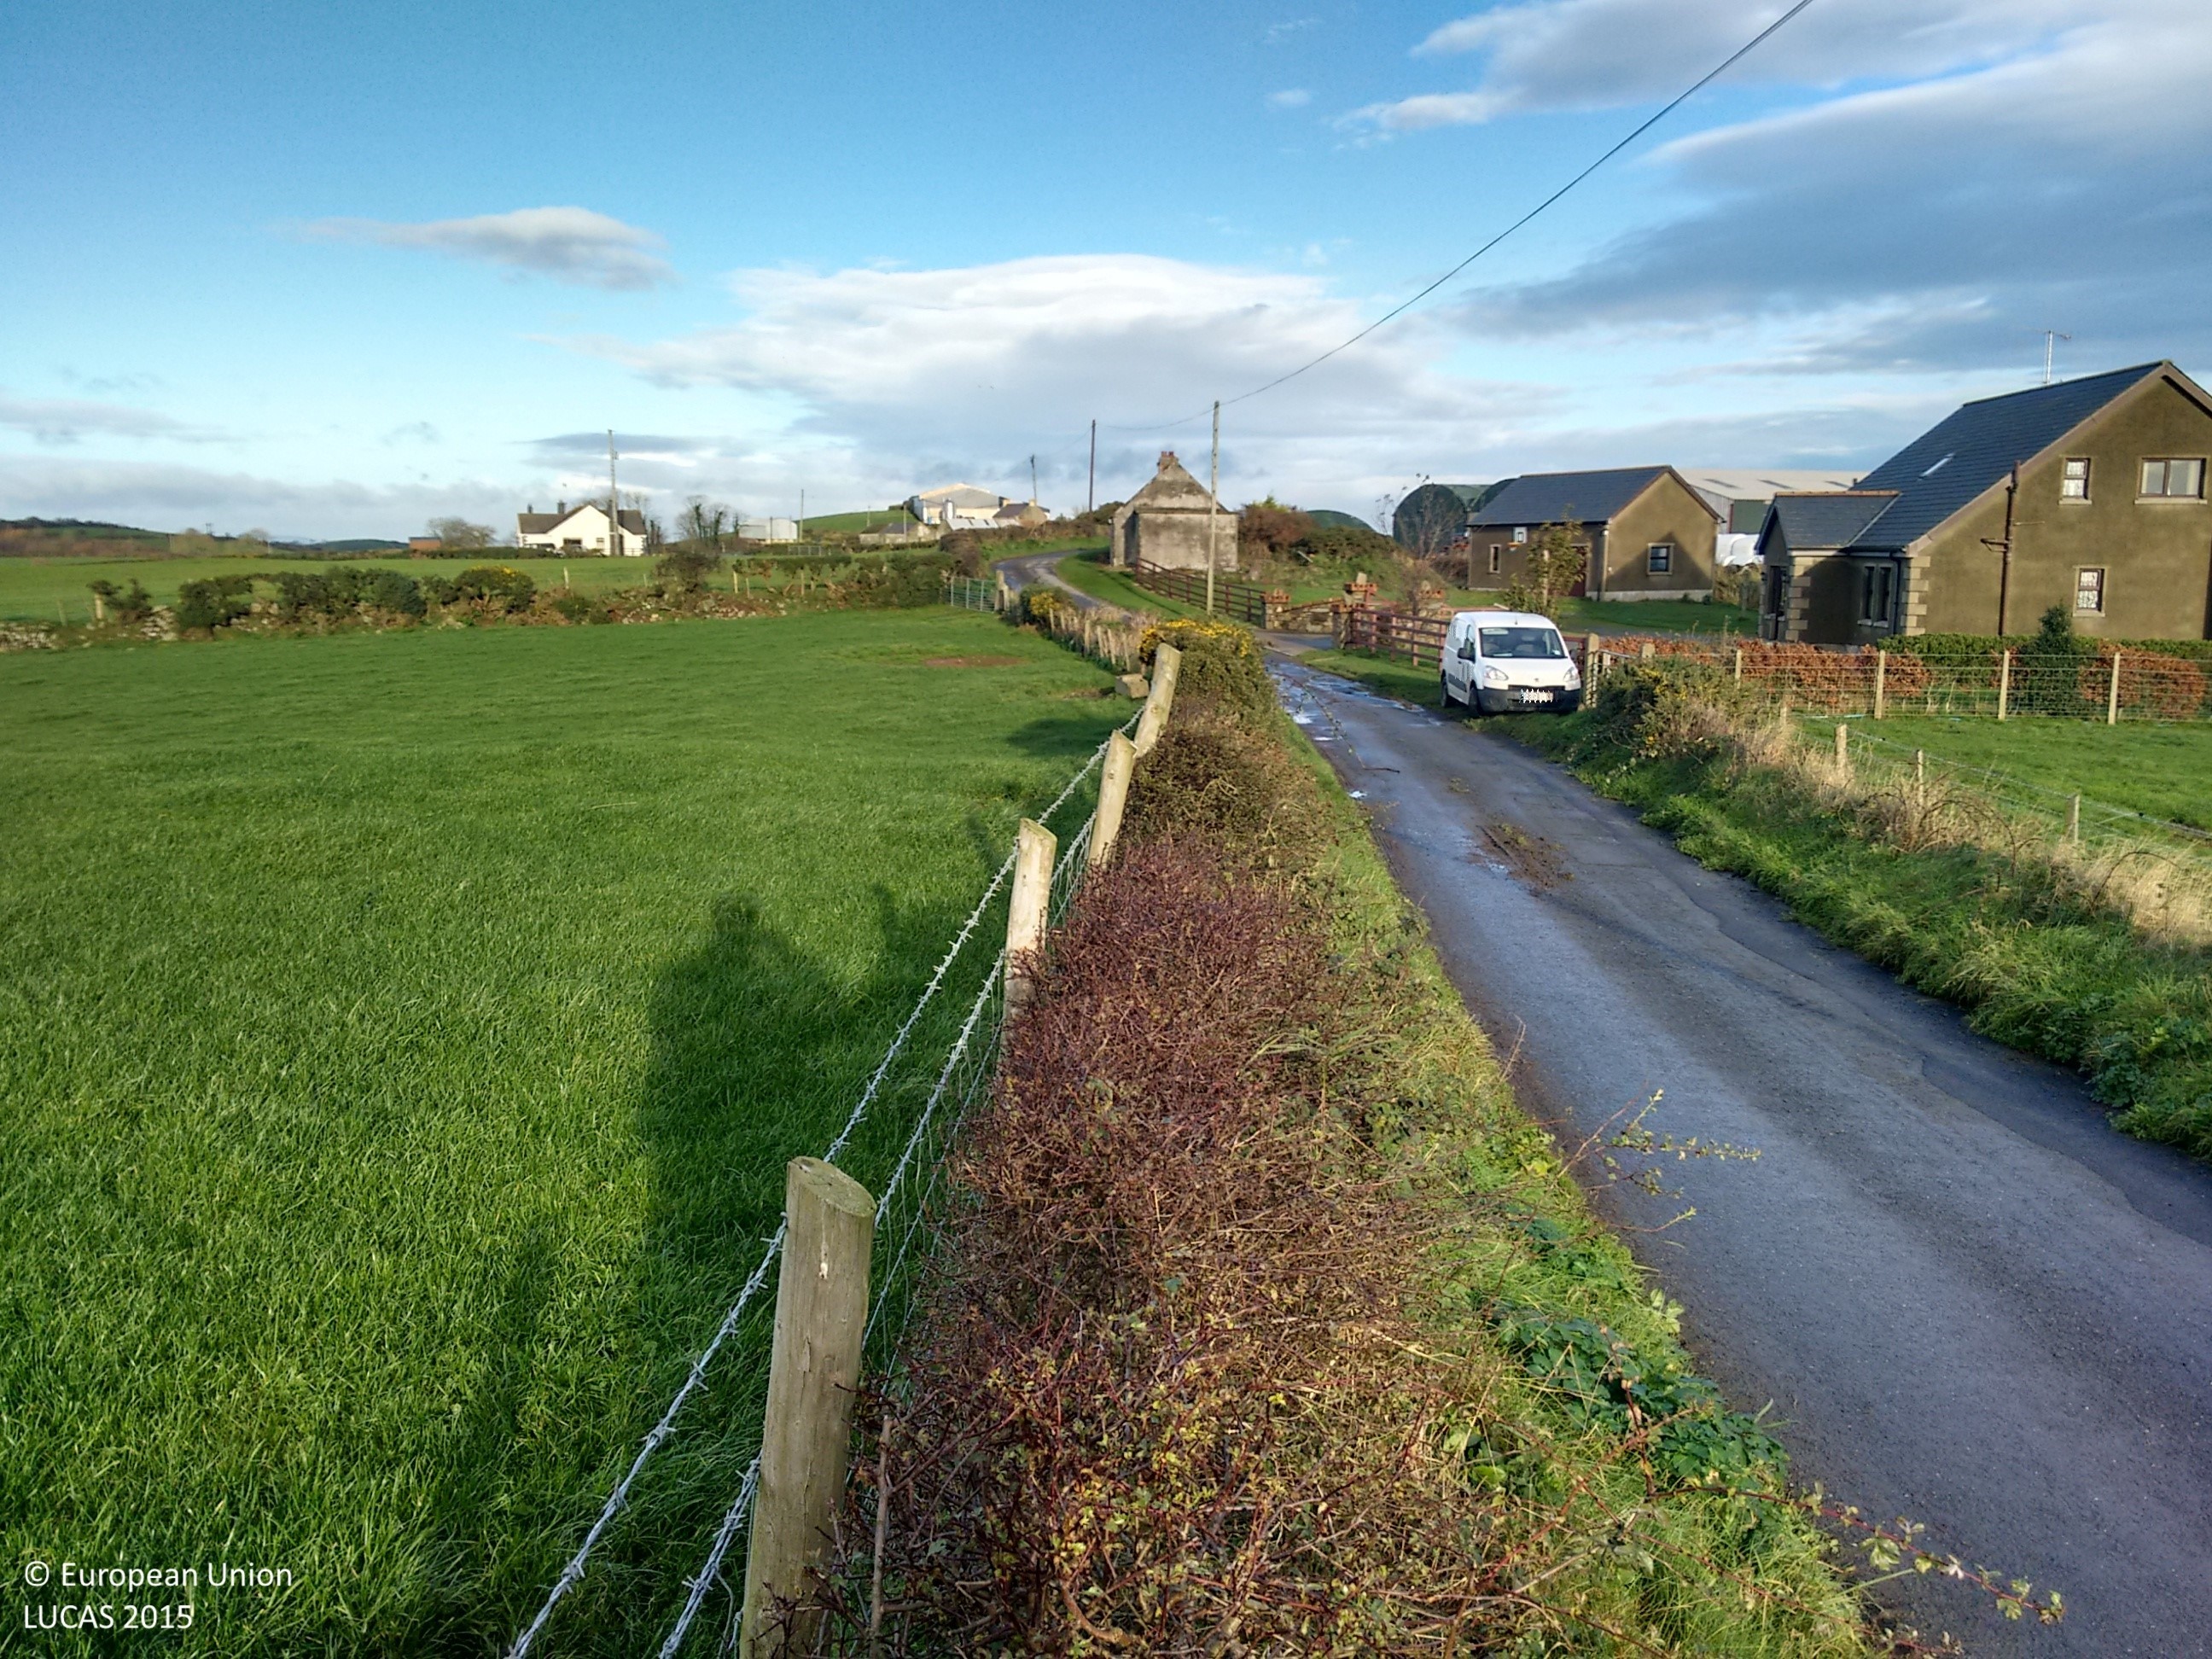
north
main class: Grassland
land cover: Grassland without tree/shrub cover
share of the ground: > 75 %
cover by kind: herbaceous plants 100 %
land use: Agriculture (excluding fallow land and kitchen gardens)
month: November
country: GB
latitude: 54.4132
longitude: -5.4898
